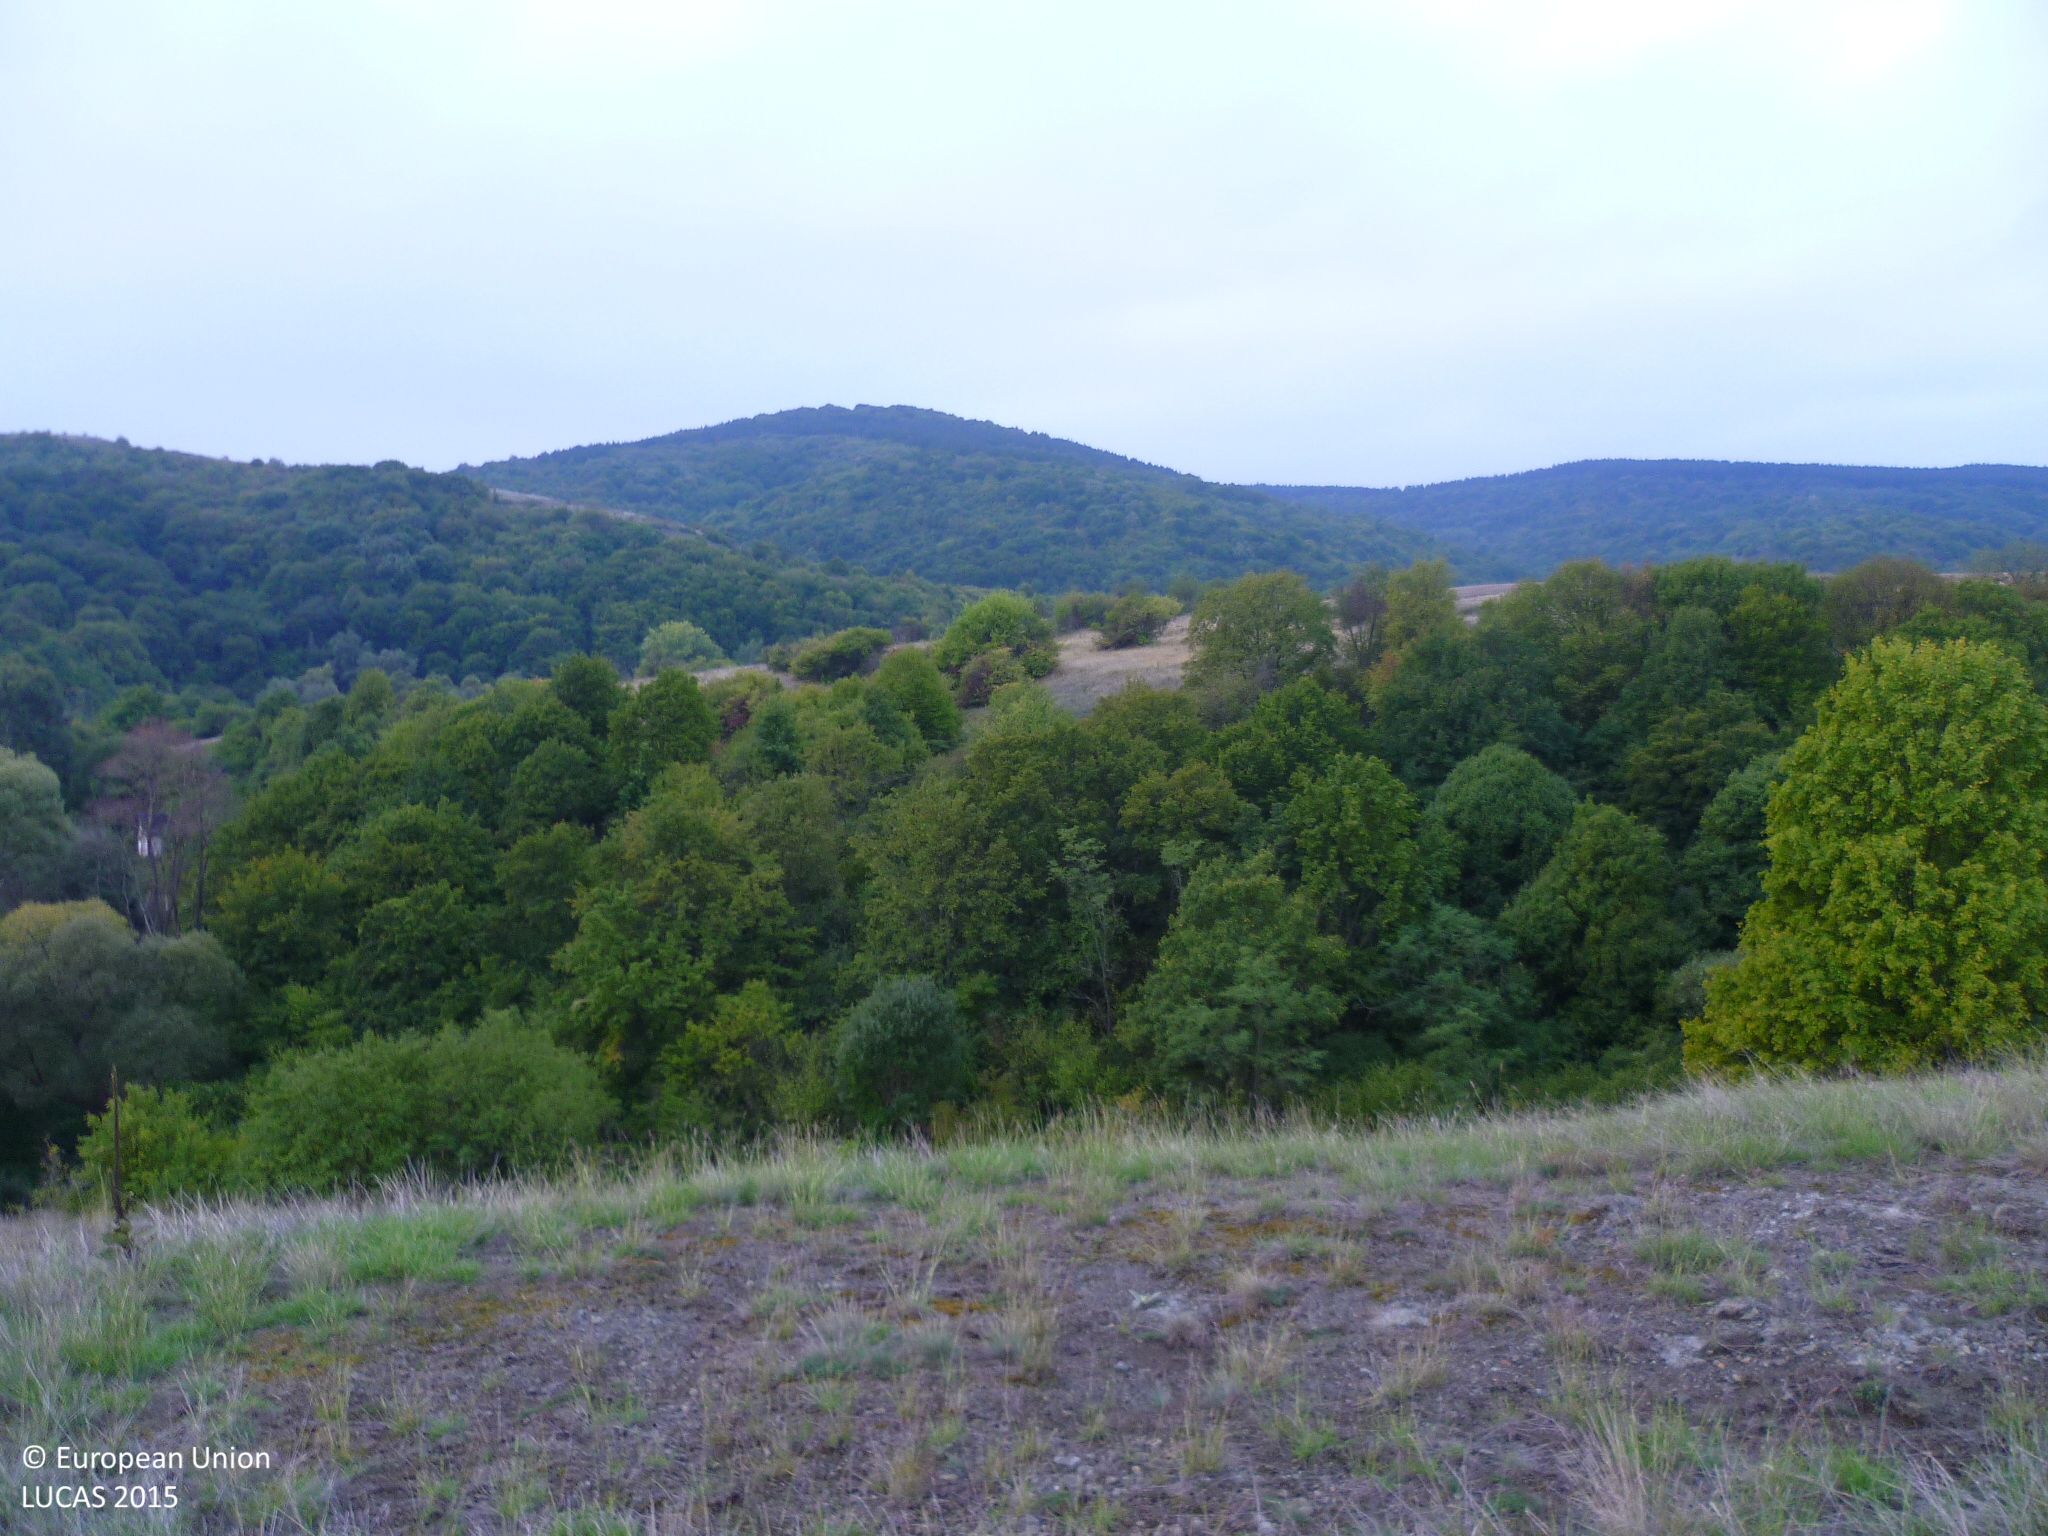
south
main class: Grassland
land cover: Grassland without tree/shrub cover
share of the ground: > 75 %
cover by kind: herbaceous plants 100 %
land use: Agriculture (excluding fallow land and kitchen gardens)
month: September
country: BG
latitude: 42.7888
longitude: 23.0757
